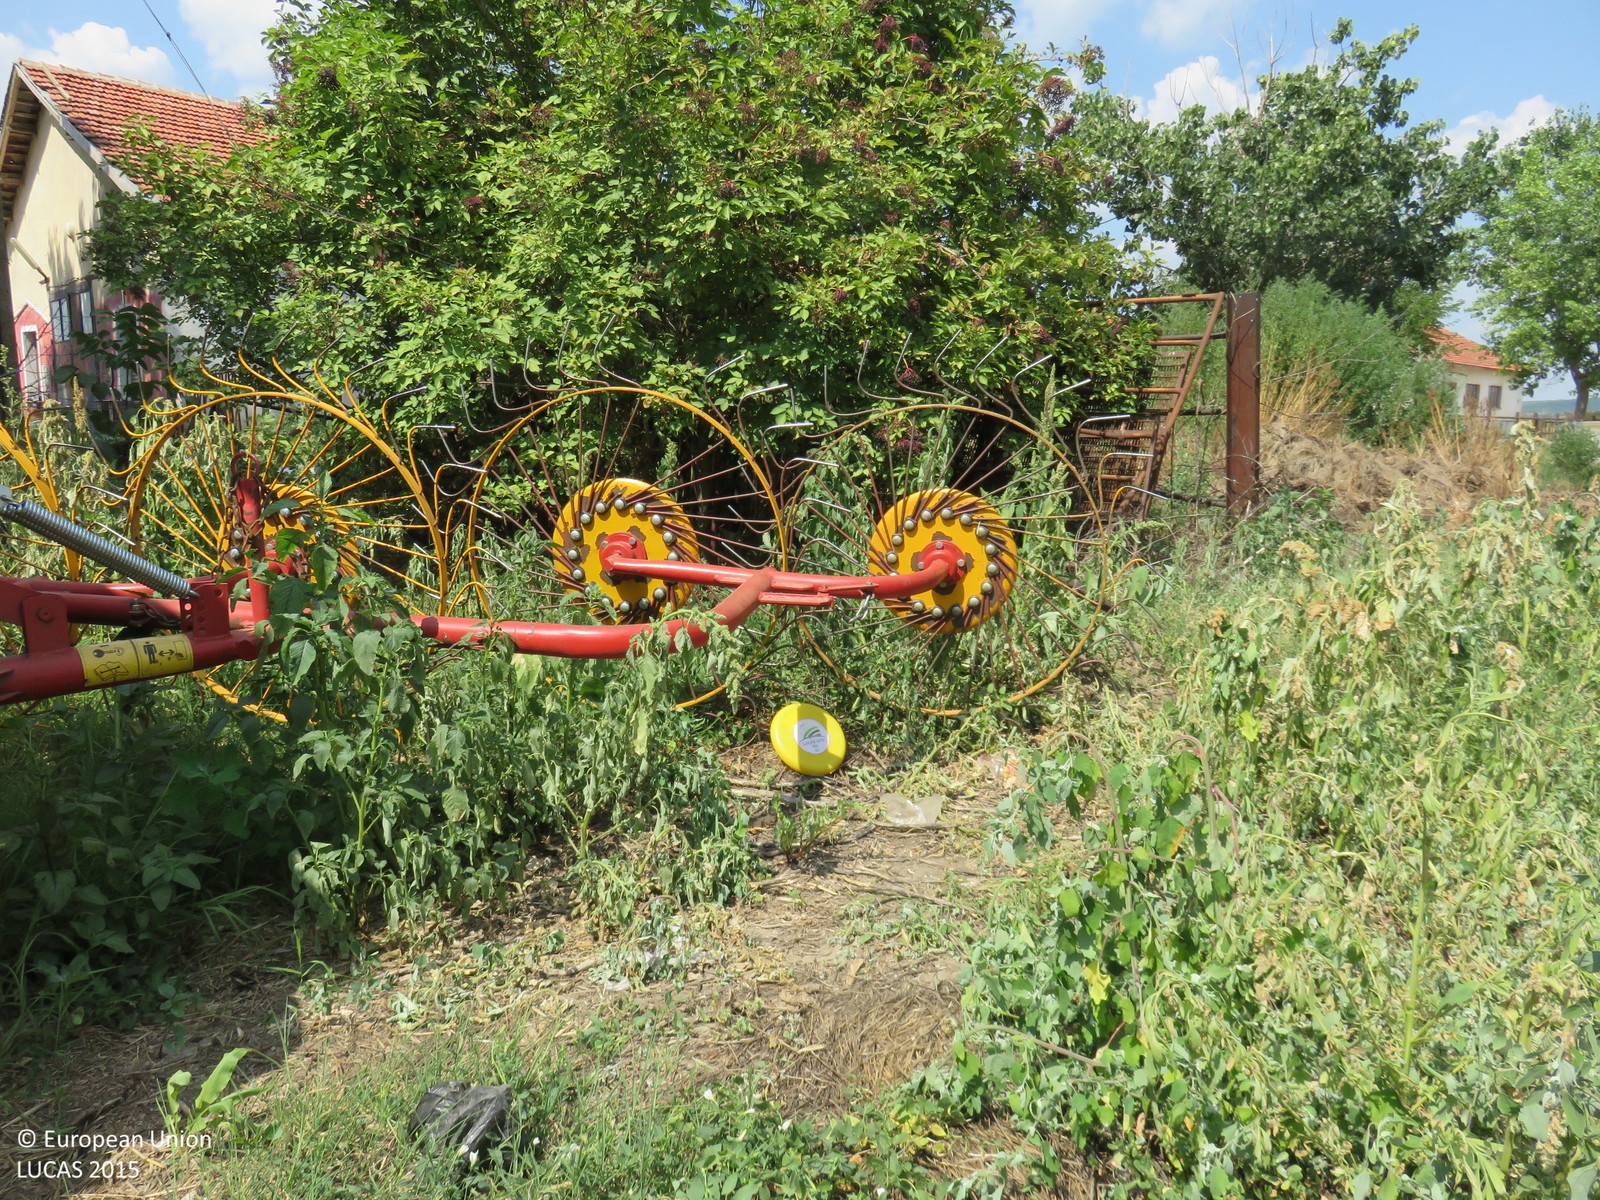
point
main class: Grassland
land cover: Spontaneously vegetated surfaces
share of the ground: > 75 %
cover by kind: herbaceous plants 90 %, unconsolidated bare surface 10 %
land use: Agriculture (excluding fallow land and kitchen gardens)
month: July
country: BG
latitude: 43.4207
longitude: 25.1040
